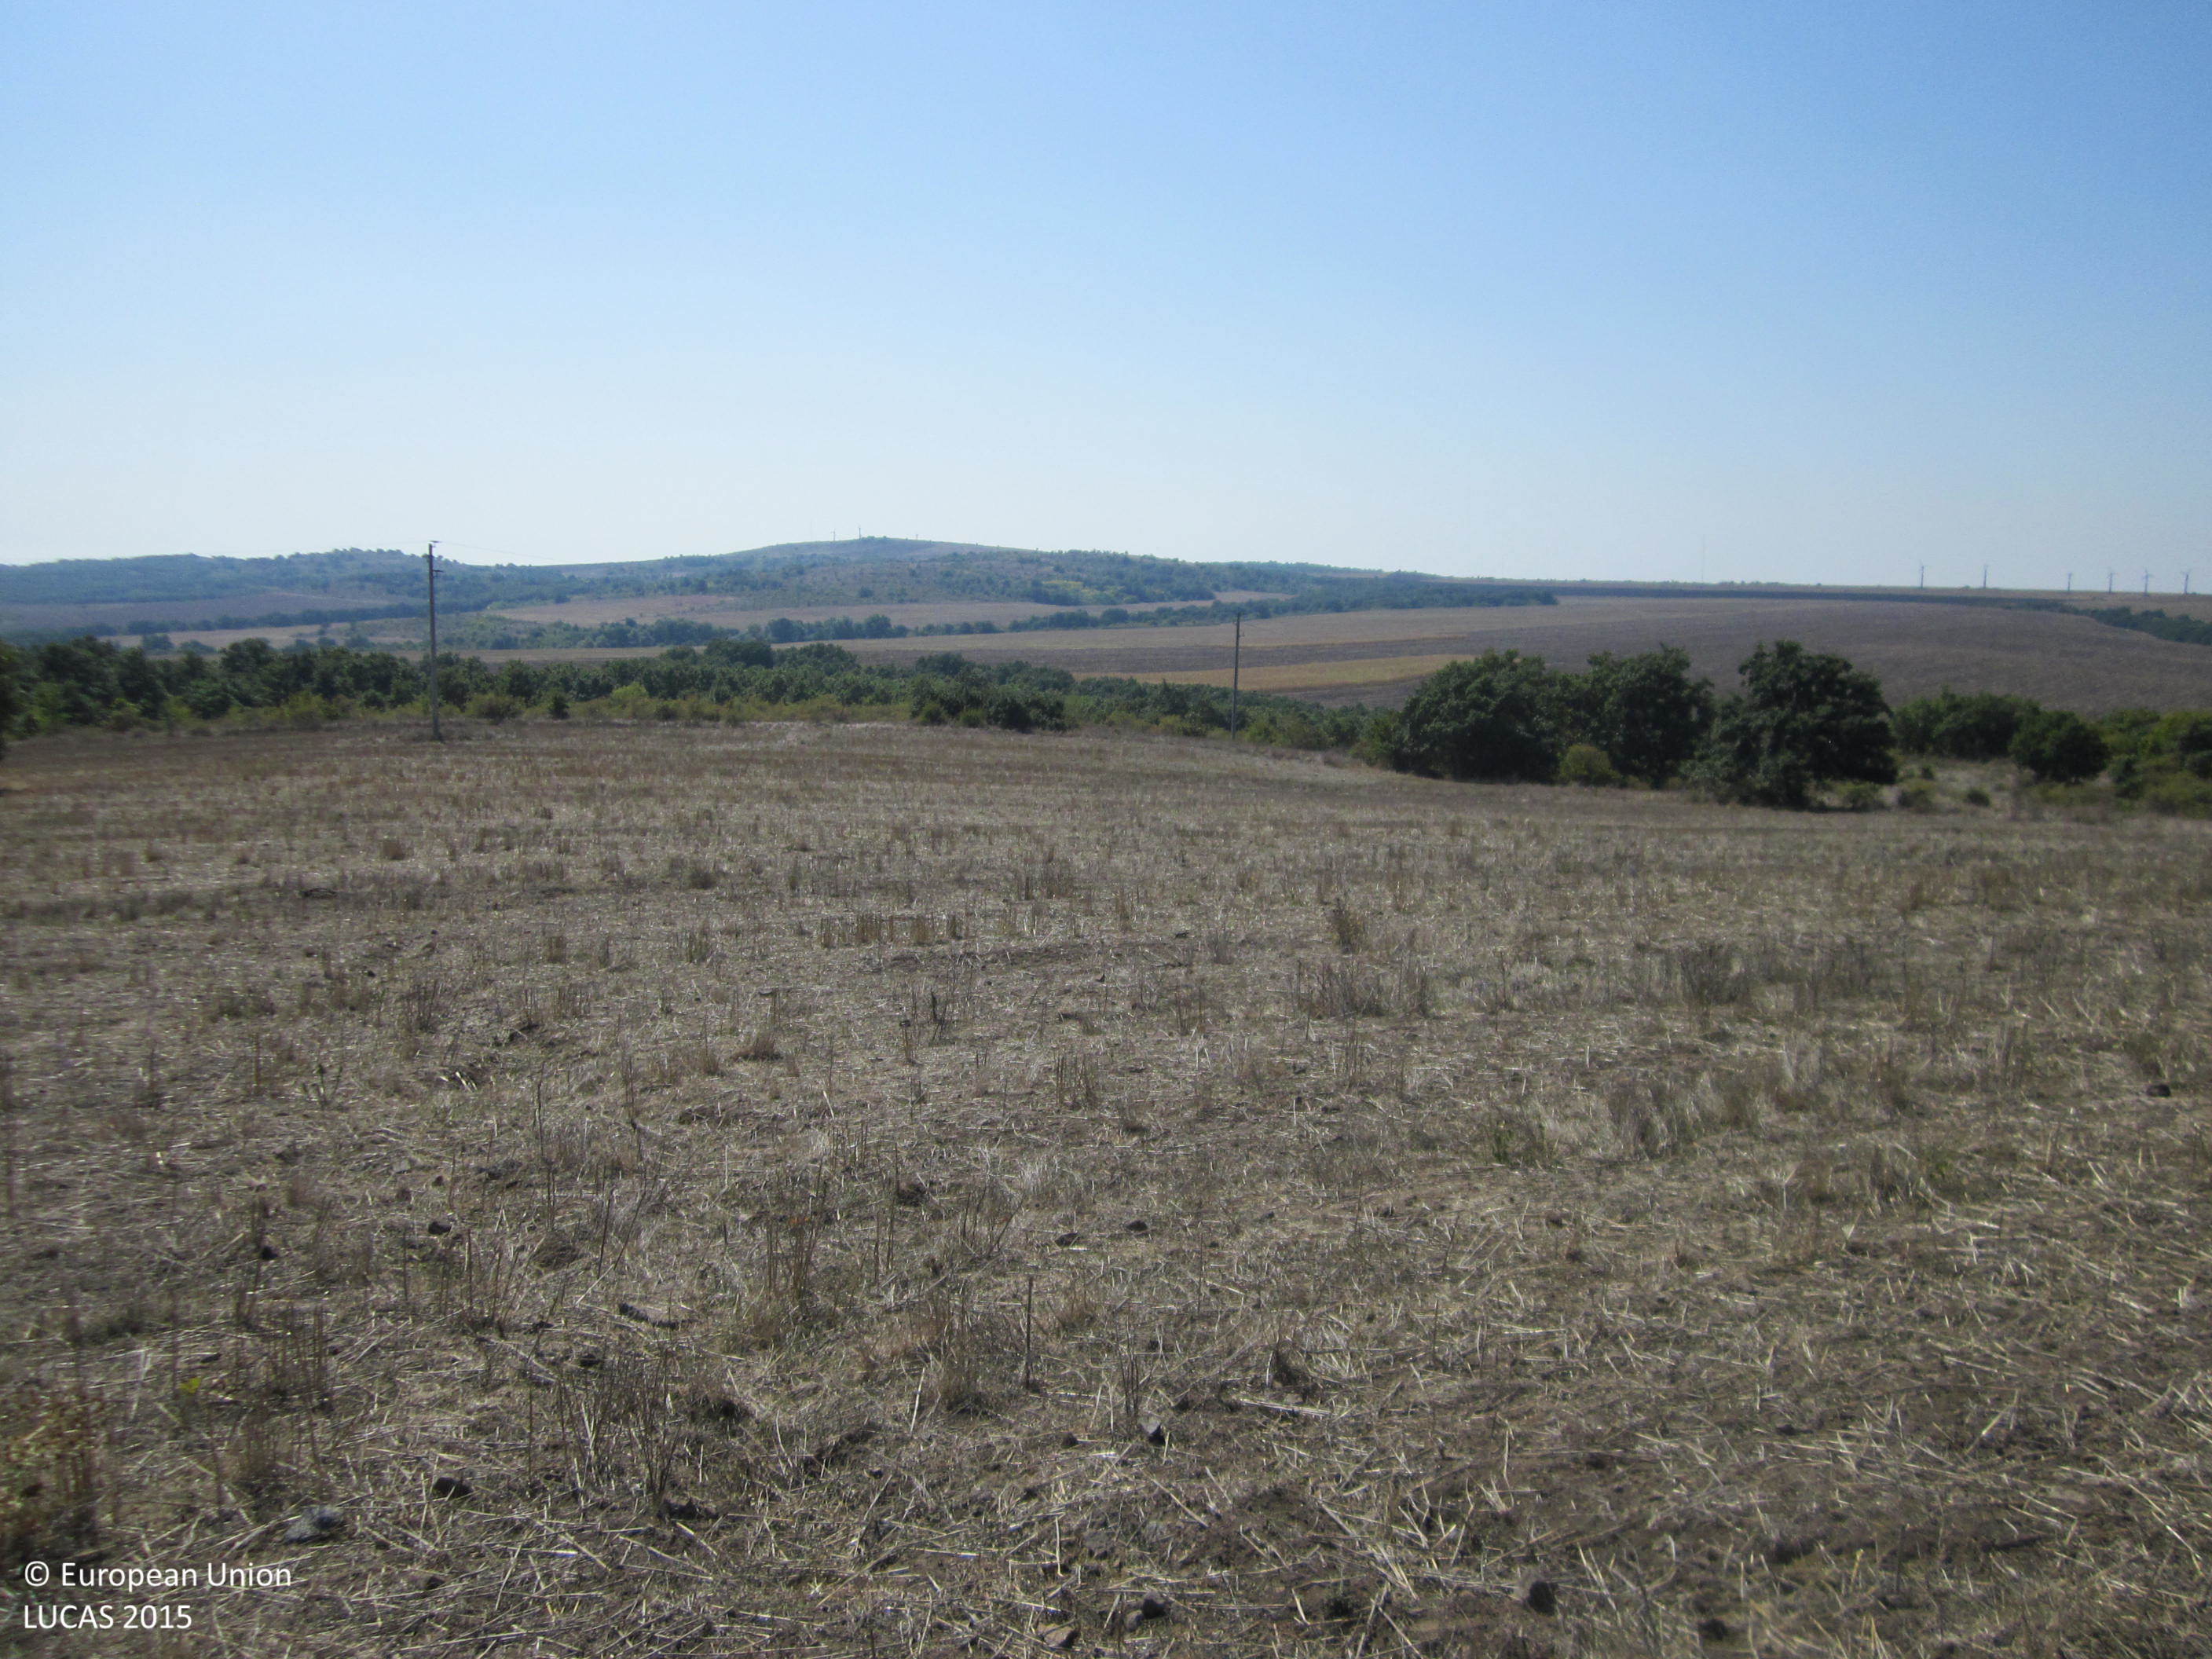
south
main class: Cropland
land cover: Common wheat
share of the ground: < 10 %
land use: Agriculture (excluding fallow land and kitchen gardens)
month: September
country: BG
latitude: 42.6980
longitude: 27.4157
